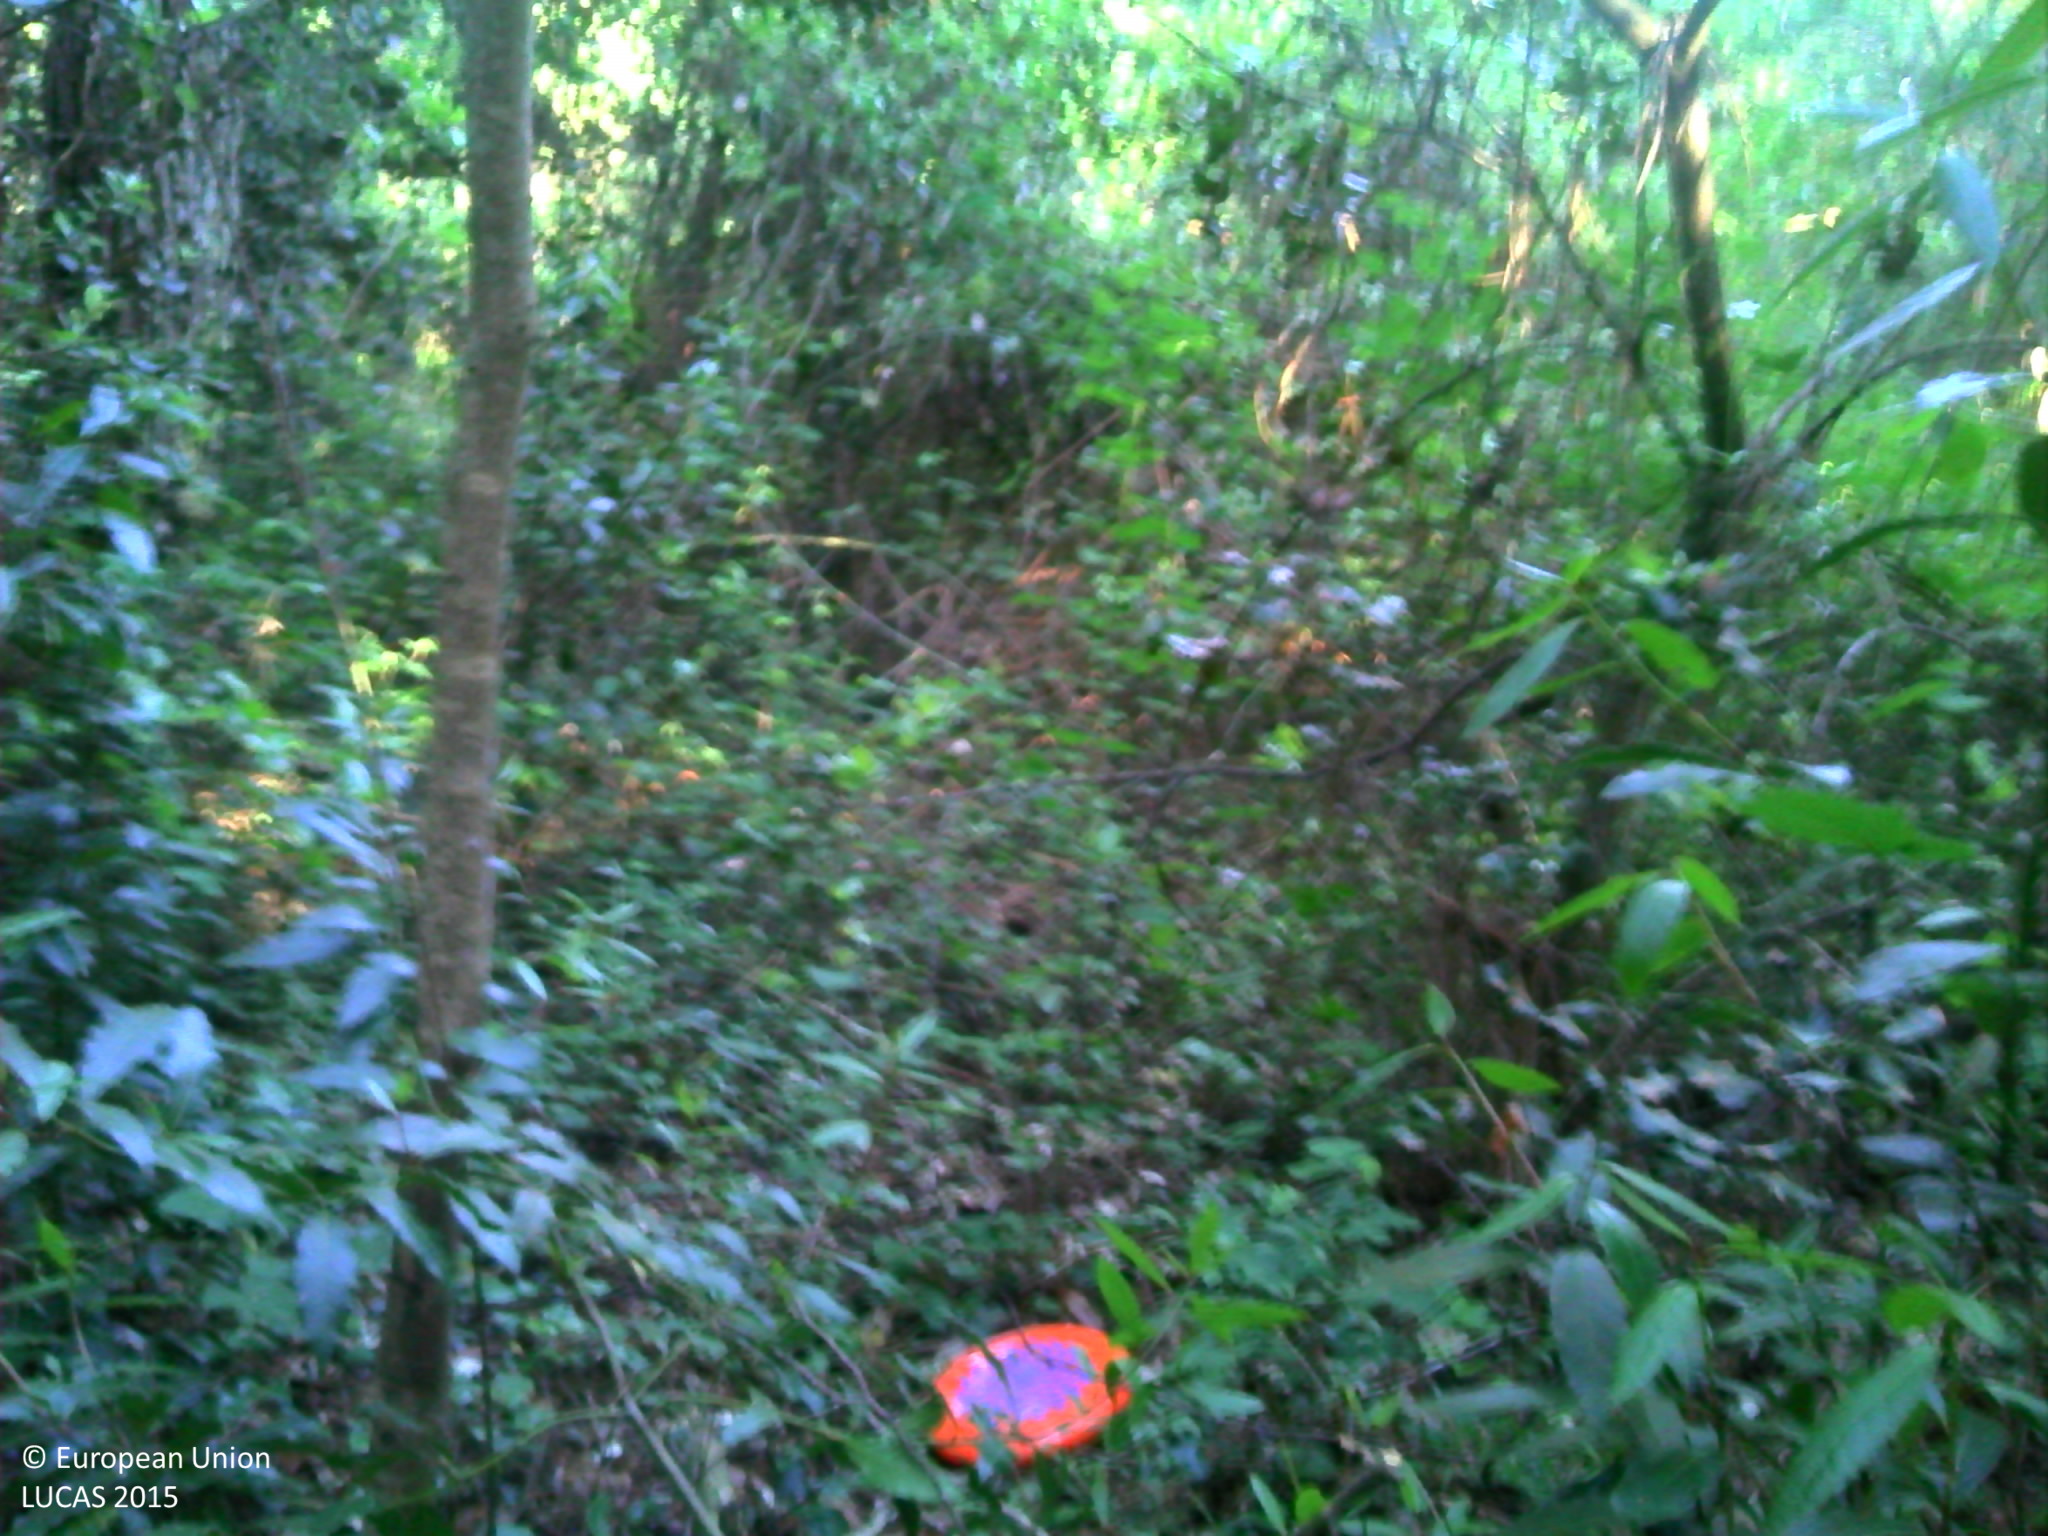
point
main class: Woodland
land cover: Pine dominated mixed woodland
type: coniferous forest of the mediterranean region
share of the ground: > 75 %
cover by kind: coniferous forest trees 75 %, broadleaved forest trees 25 %
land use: Forestry
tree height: > 5 m
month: May
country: FR
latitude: 45.8318
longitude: -1.2179
